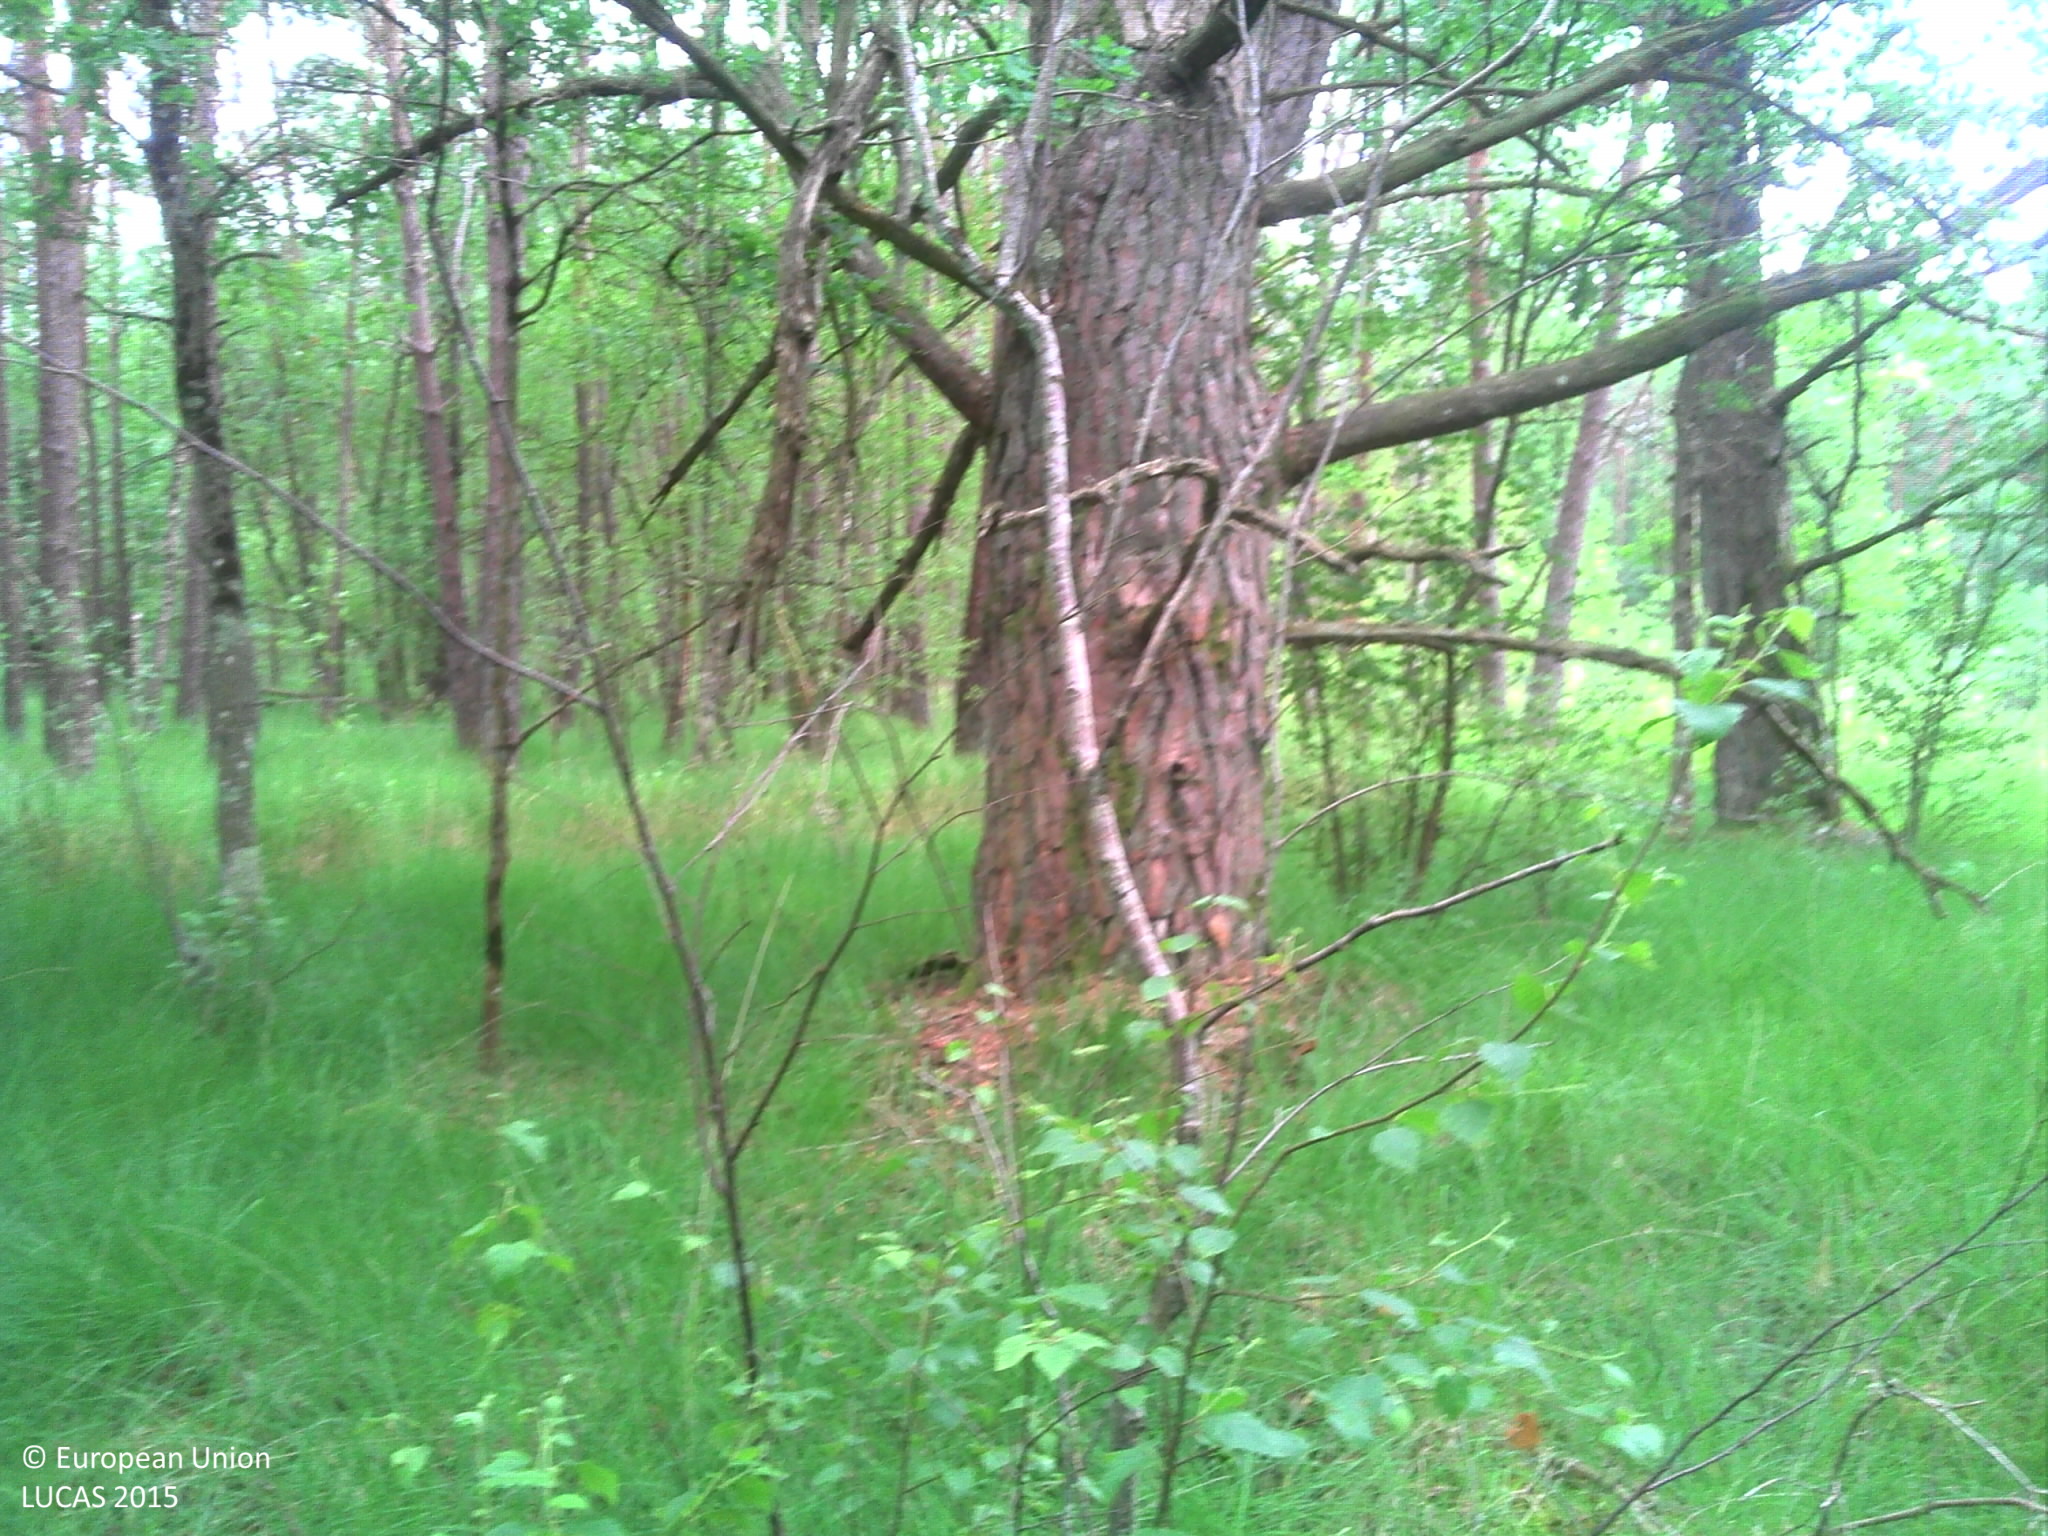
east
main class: Woodland
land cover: Pine dominated mixed woodland
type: thermophilous deciduous forest
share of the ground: > 75 %
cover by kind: herbaceous plants 60 %, coniferous forest trees 15 %, broadleaved forest trees 15 %, lichens and mosses 10 %
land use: Amenities, museums, leisure
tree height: > 5 m
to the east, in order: Pine dominated mixed woodland; Tracks; Pine dominated mixed woodland
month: June
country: FR
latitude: 47.5211
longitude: 2.0611
